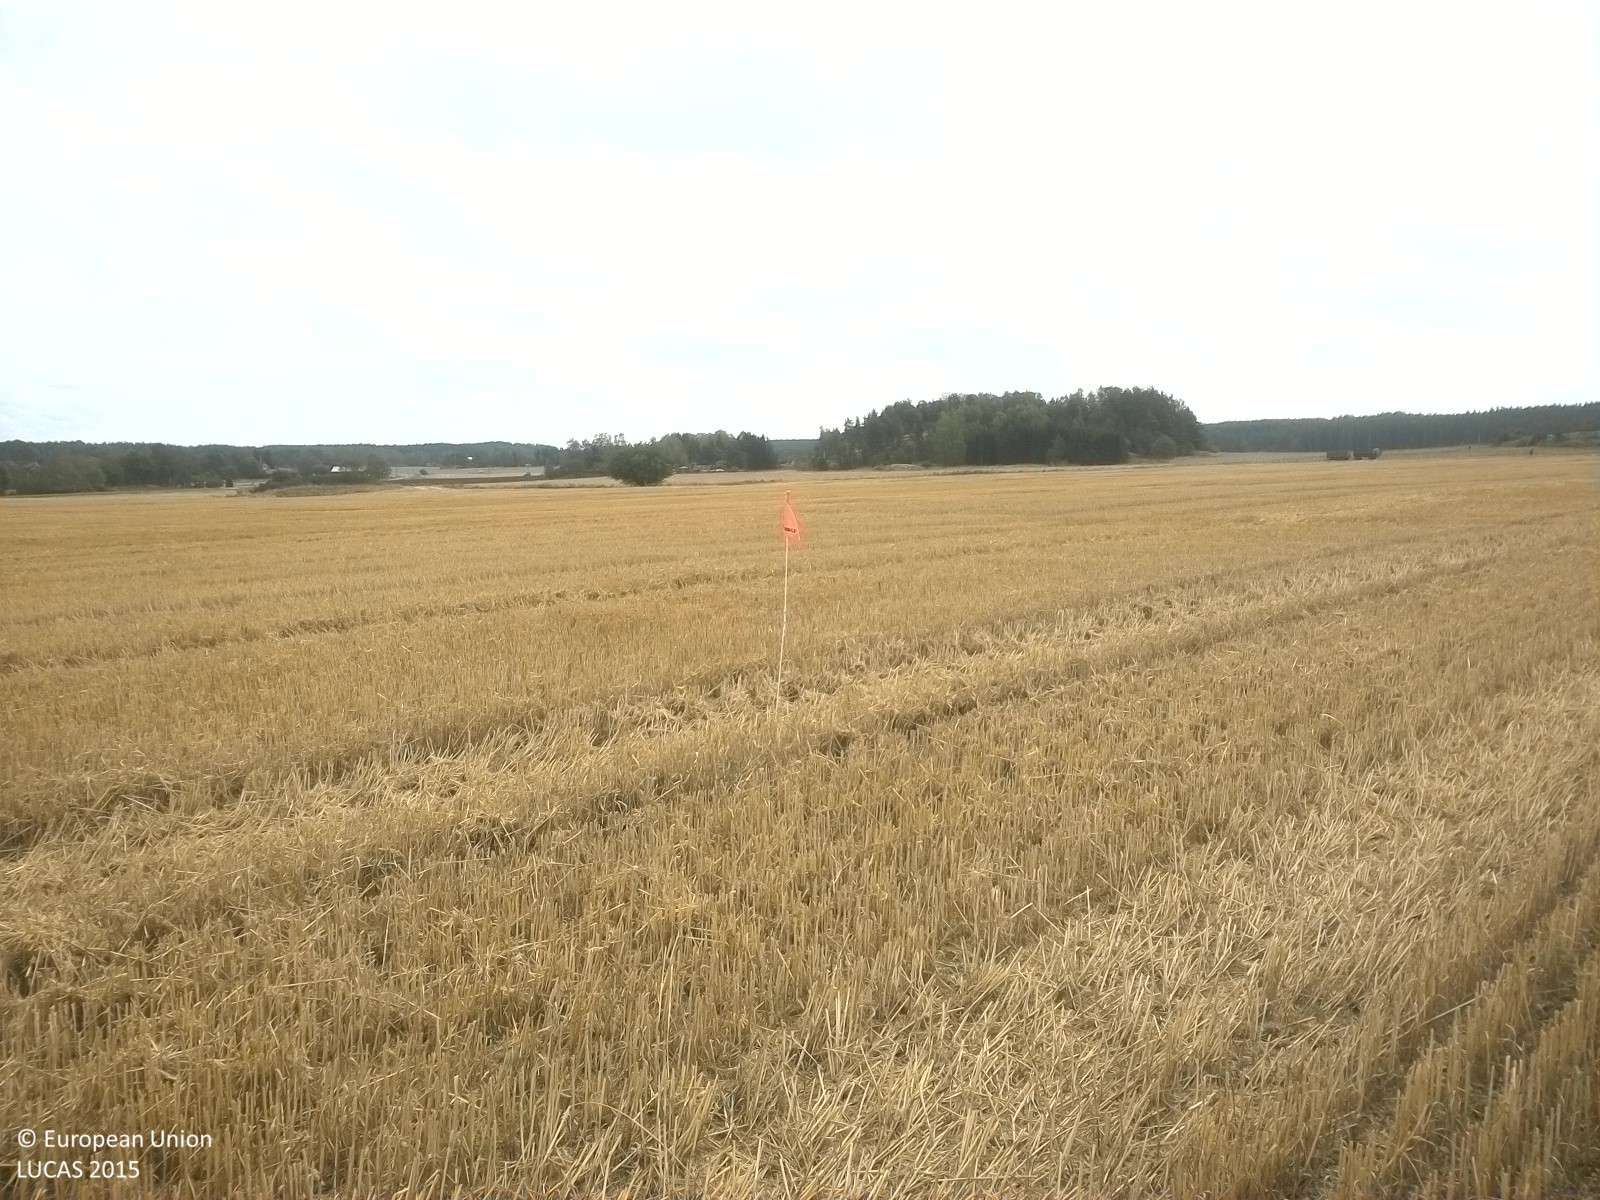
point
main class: Cropland
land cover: Common wheat
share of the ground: > 75 %
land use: Agriculture (excluding fallow land and kitchen gardens)
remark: Harvested field
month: September
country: SE
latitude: 58.5721
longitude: 16.4092
